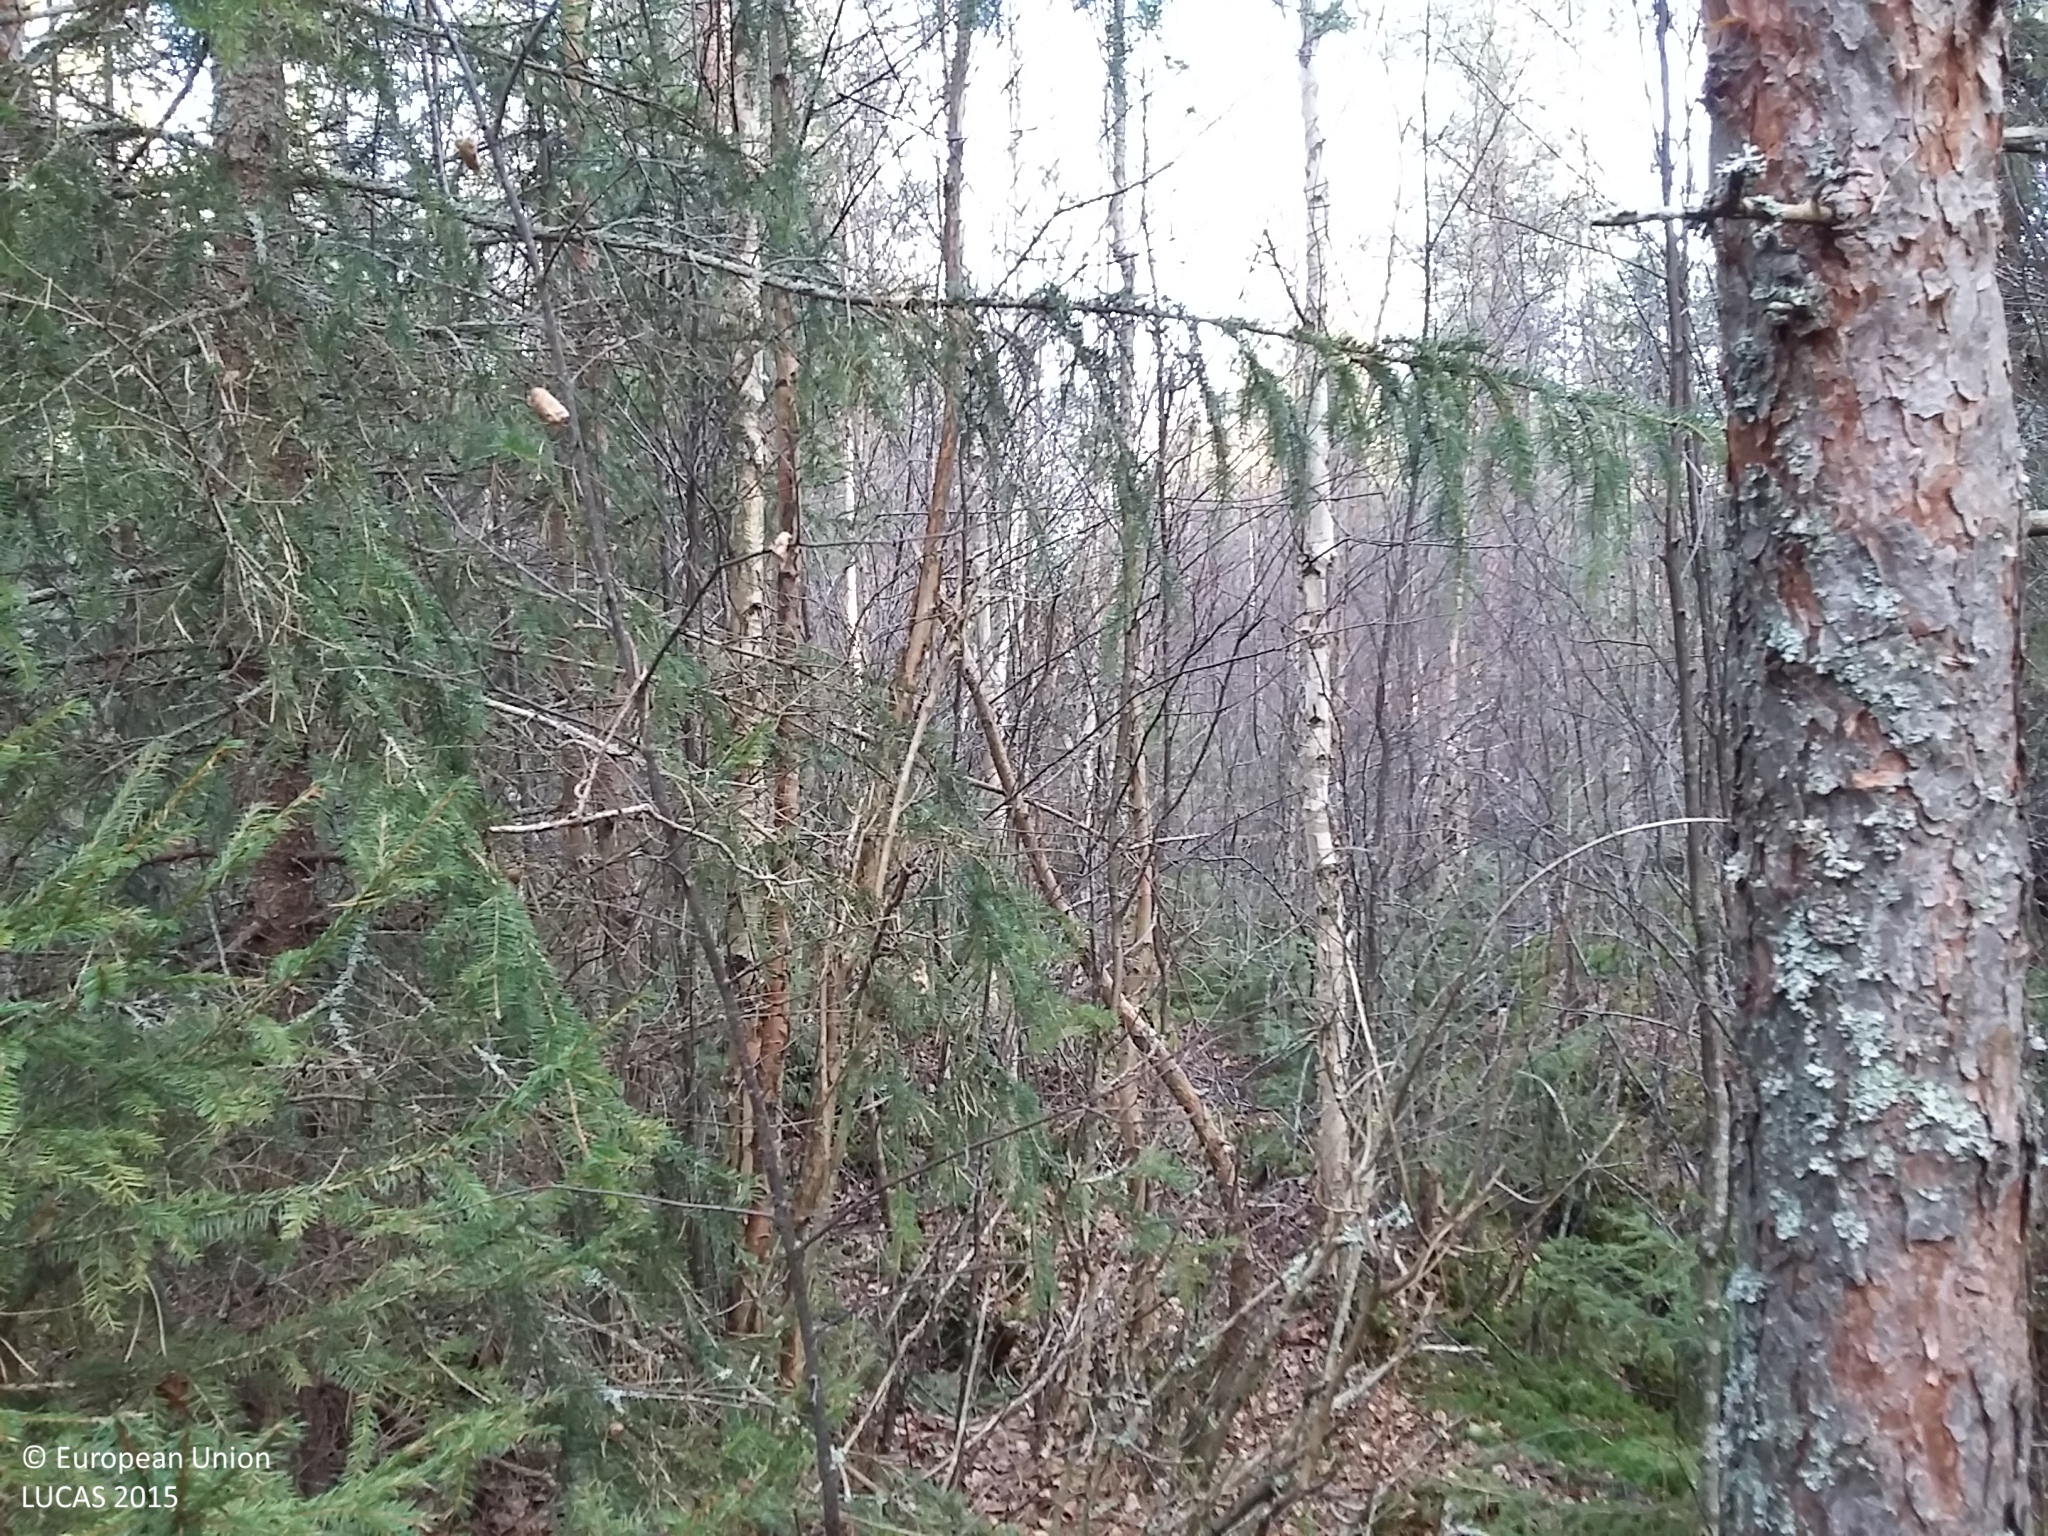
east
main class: Woodland
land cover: Other mixed woodland
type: boreal forest
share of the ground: > 75 %
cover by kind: coniferous forest trees 55 %, broadleaved forest trees 25 %, shrubs 10 %, lichens and mosses 10 %
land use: Forestry
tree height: > 5 m
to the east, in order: Other mixed woodland; Pine dominated coniferous woodland; Tracks; Pine dominated coniferous woodland; Ditches and canals; Grass margins; Grassland without tree/shrub cover
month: October
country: FI
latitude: 64.5848
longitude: 25.5649
